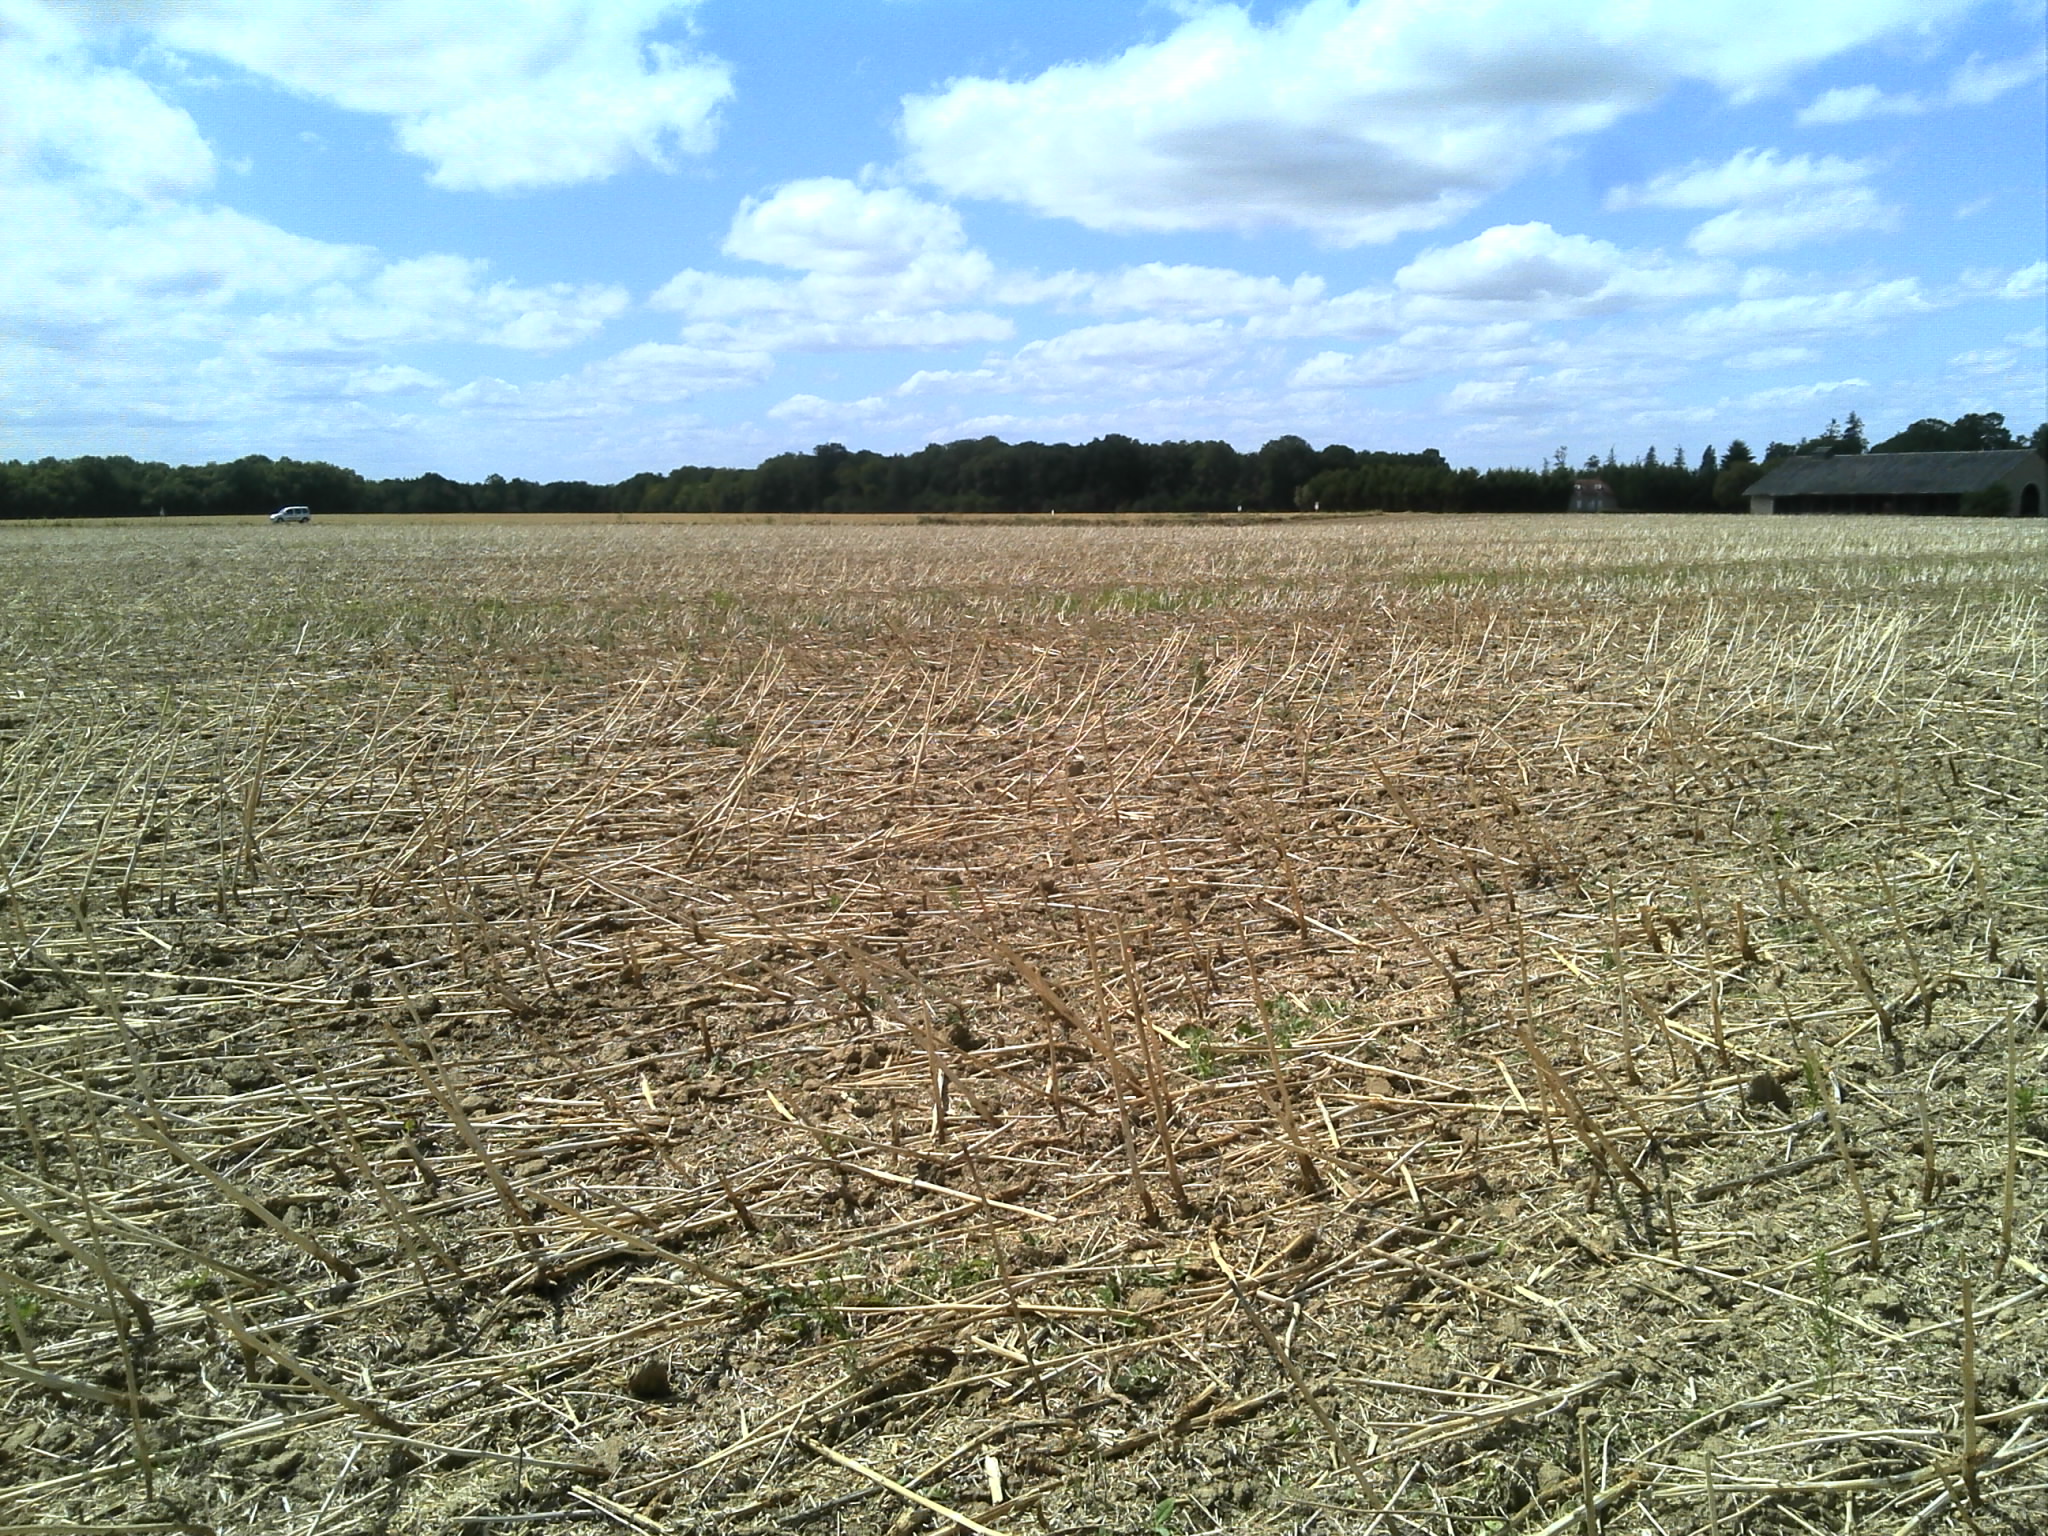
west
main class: Cropland
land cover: Rape and turnip rape
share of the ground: < 10 %
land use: Agriculture (excluding fallow land and kitchen gardens)
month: August
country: FR
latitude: 46.8557
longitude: 1.6344
